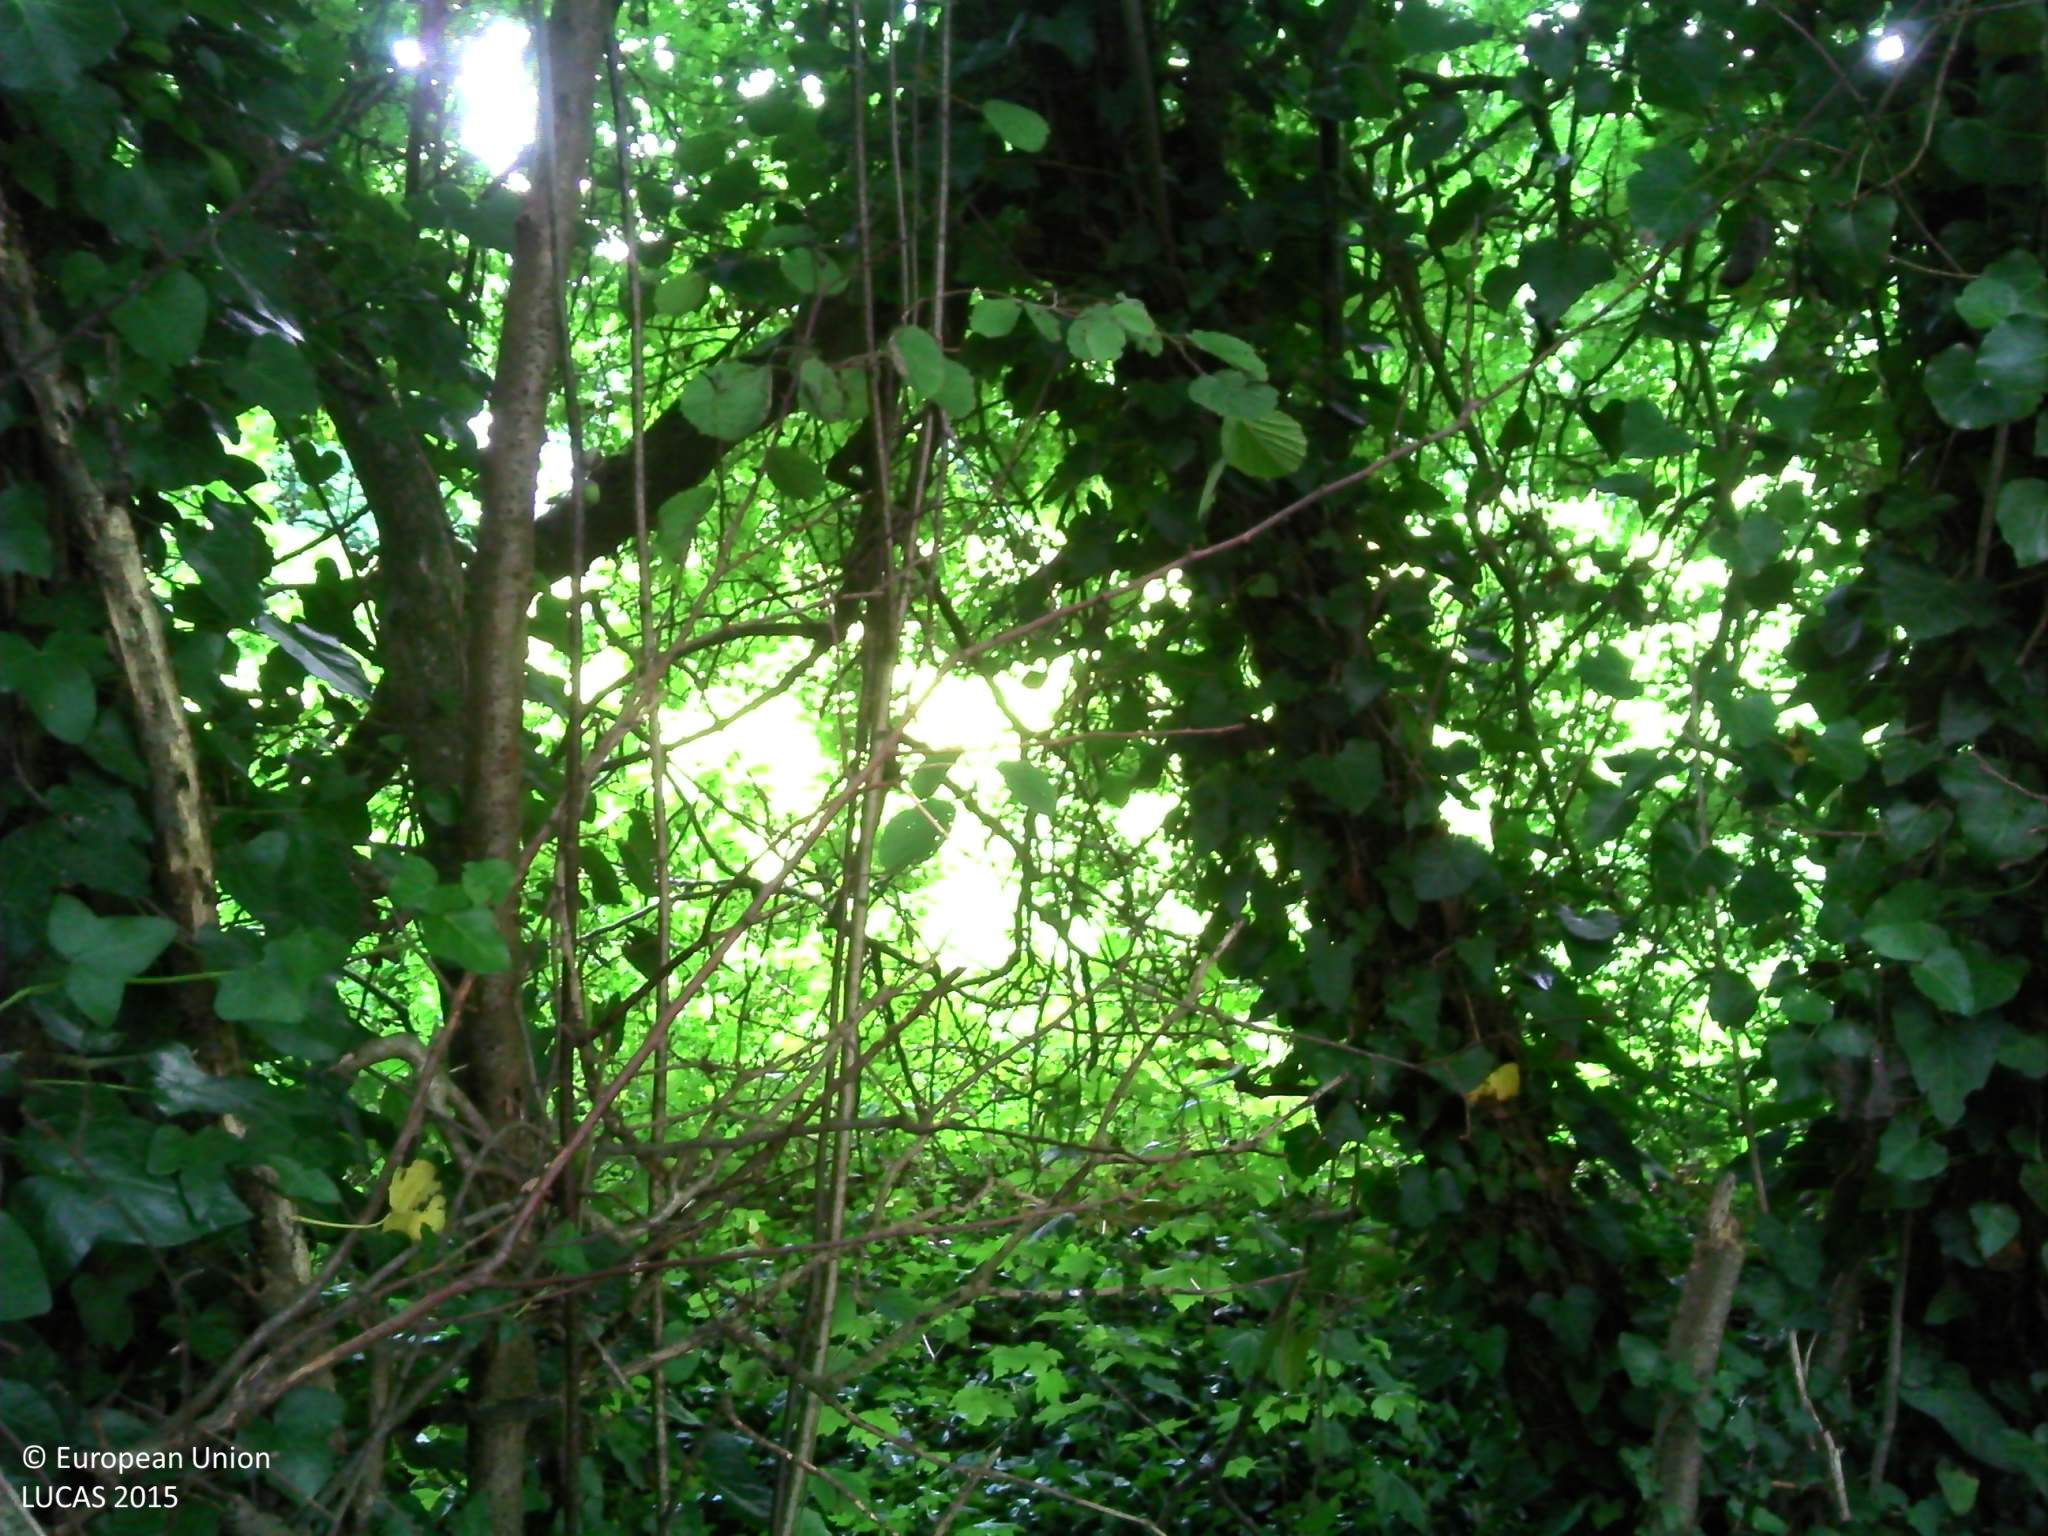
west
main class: Woodland
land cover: Broadleaved woodland
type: acidophilous oak and oak-birch forest
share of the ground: > 75 %
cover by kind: unconsolidated bare surface 60 %, broadleaved forest trees 30 %, herbaceous plants 10 %
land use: Amenities, museums, leisure
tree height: > 5 m
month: August
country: FR
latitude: 48.6085
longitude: -3.2164
